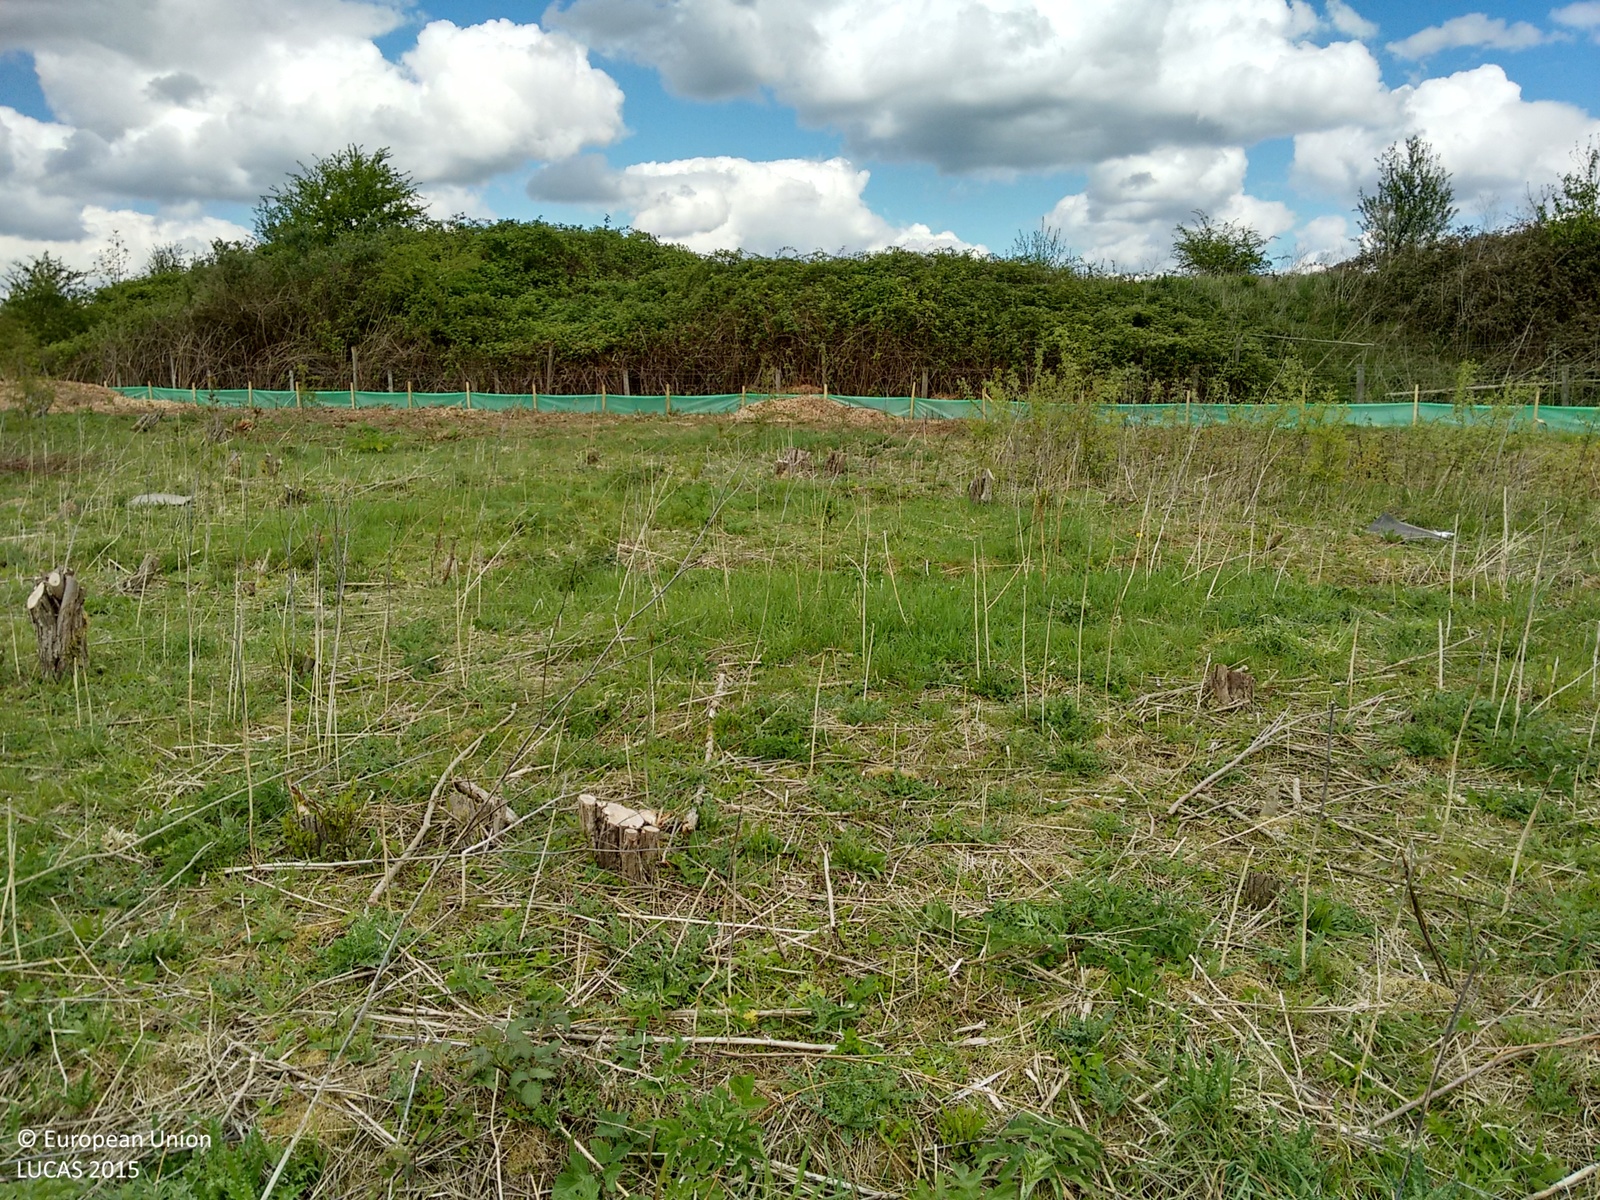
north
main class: Grassland
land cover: Grassland without tree/shrub cover
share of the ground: > 75 %
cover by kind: herbaceous plants 100 %
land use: Agriculture (excluding fallow land and kitchen gardens)
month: April
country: GB
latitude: 51.5636
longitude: -0.5261
